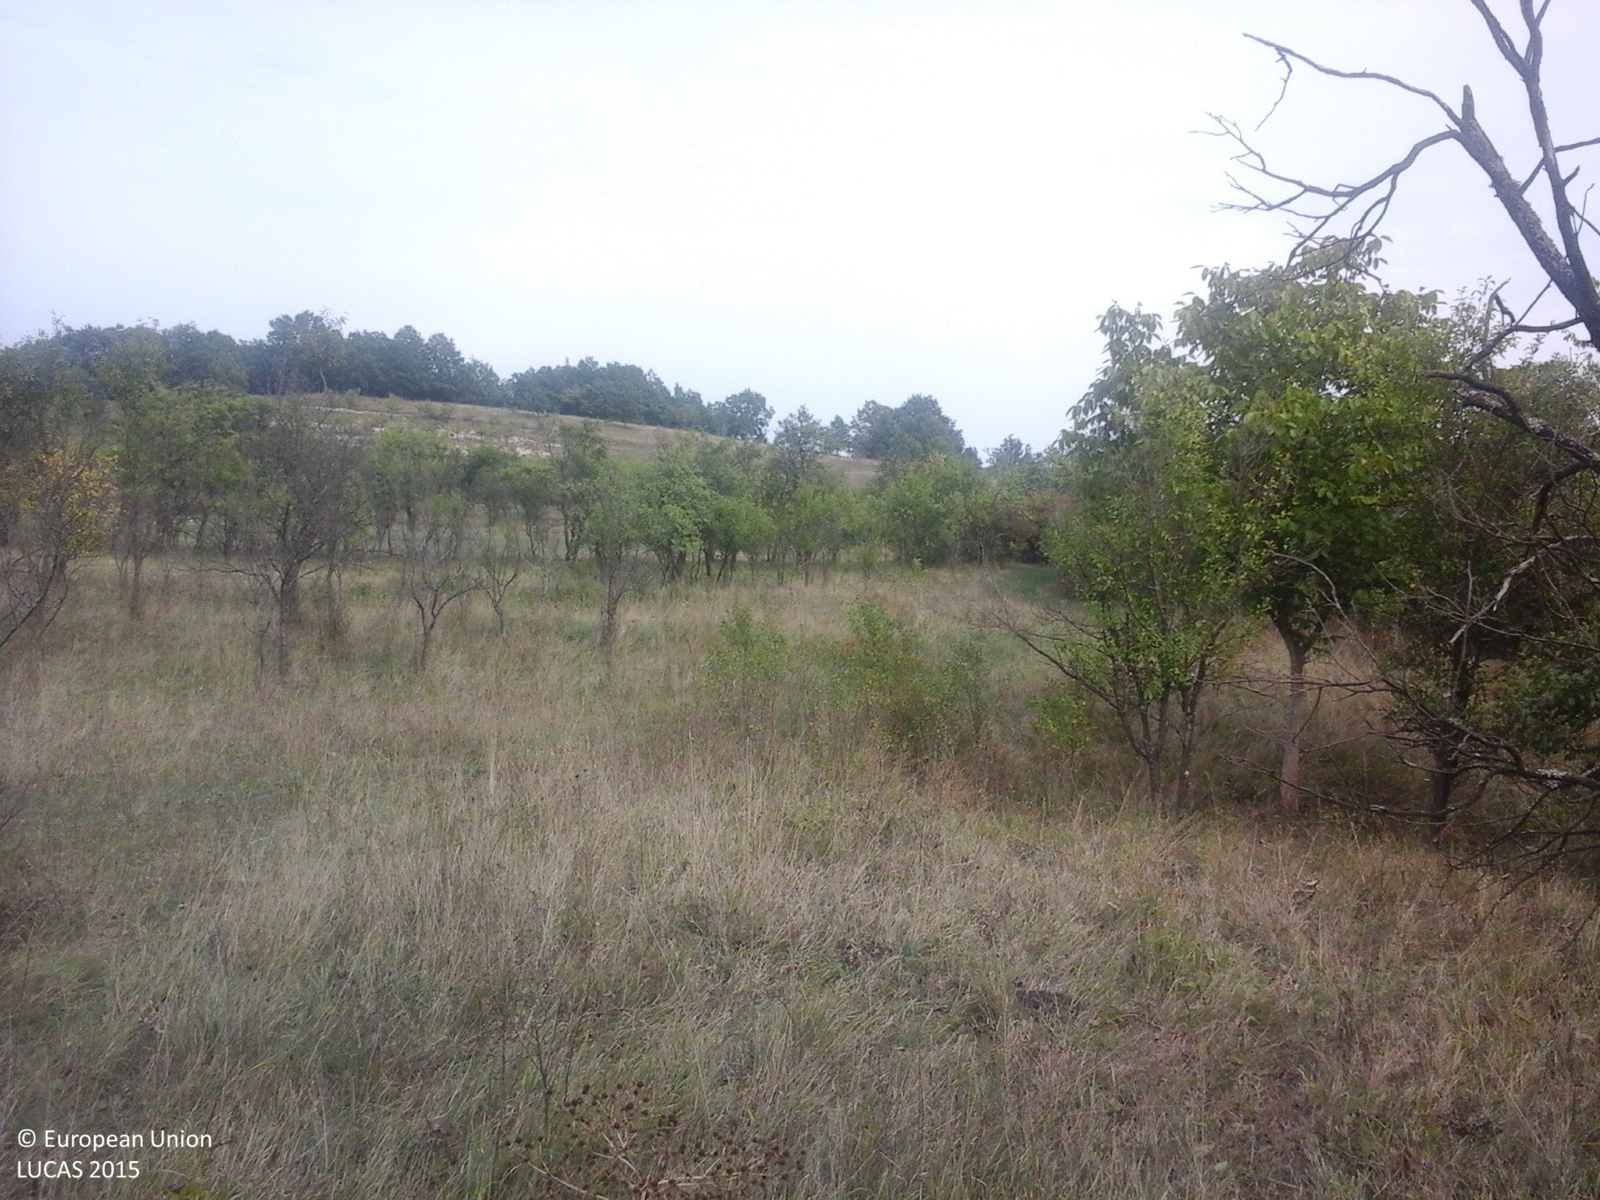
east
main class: Shrubland
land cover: Shrubland with sparse tree cover
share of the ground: > 75 %
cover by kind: shrubs 75 %, herbaceous plants 20 %, broadleaved forest trees 5 %
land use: Fallow land
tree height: > 5 m
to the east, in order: Shrubland with sparse tree cover; Other fruit trees and berries; Grassland without tree/shrub cover; Other fruit trees and berries; Grassland without tree/shrub cover; Shrubland with sparse tree cover; Tracks; Other fruit trees and berries; Grassland with sparse tree/shrub cover; Grassland without tree/shrub cover
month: September
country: RO
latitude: 45.8086
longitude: 22.8565
